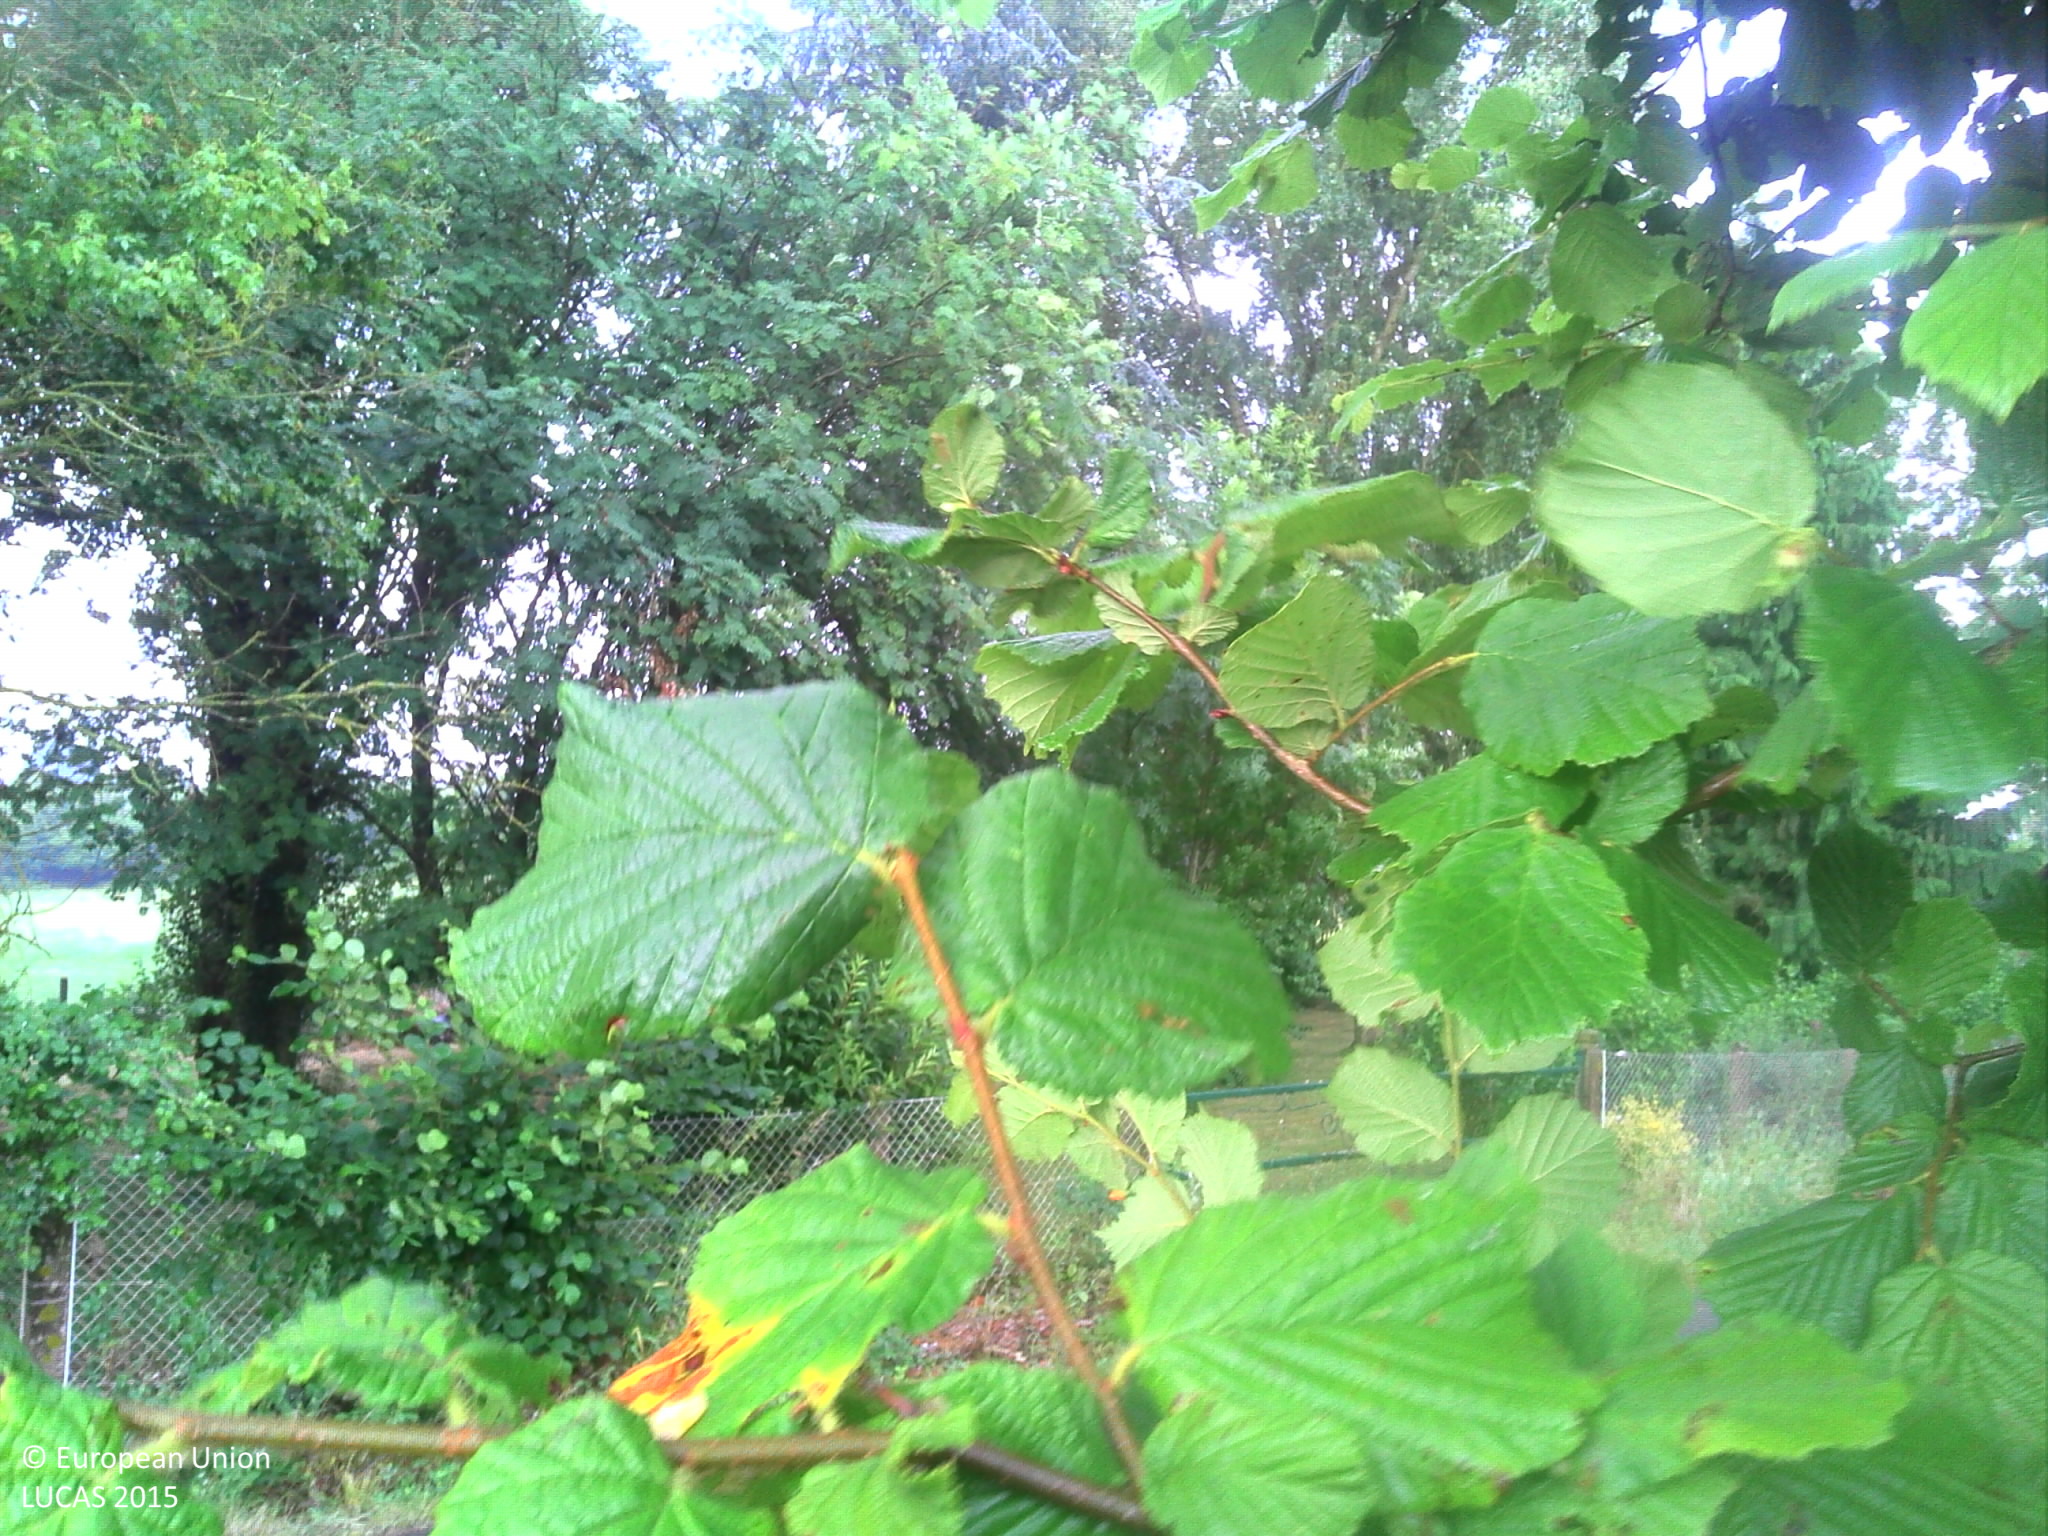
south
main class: Grassland
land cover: Grassland without tree/shrub cover
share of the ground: > 75 %
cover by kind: herbaceous plants 100 %
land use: Agriculture (excluding fallow land and kitchen gardens)
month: July
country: FR
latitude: 48.1433
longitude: 0.5554
